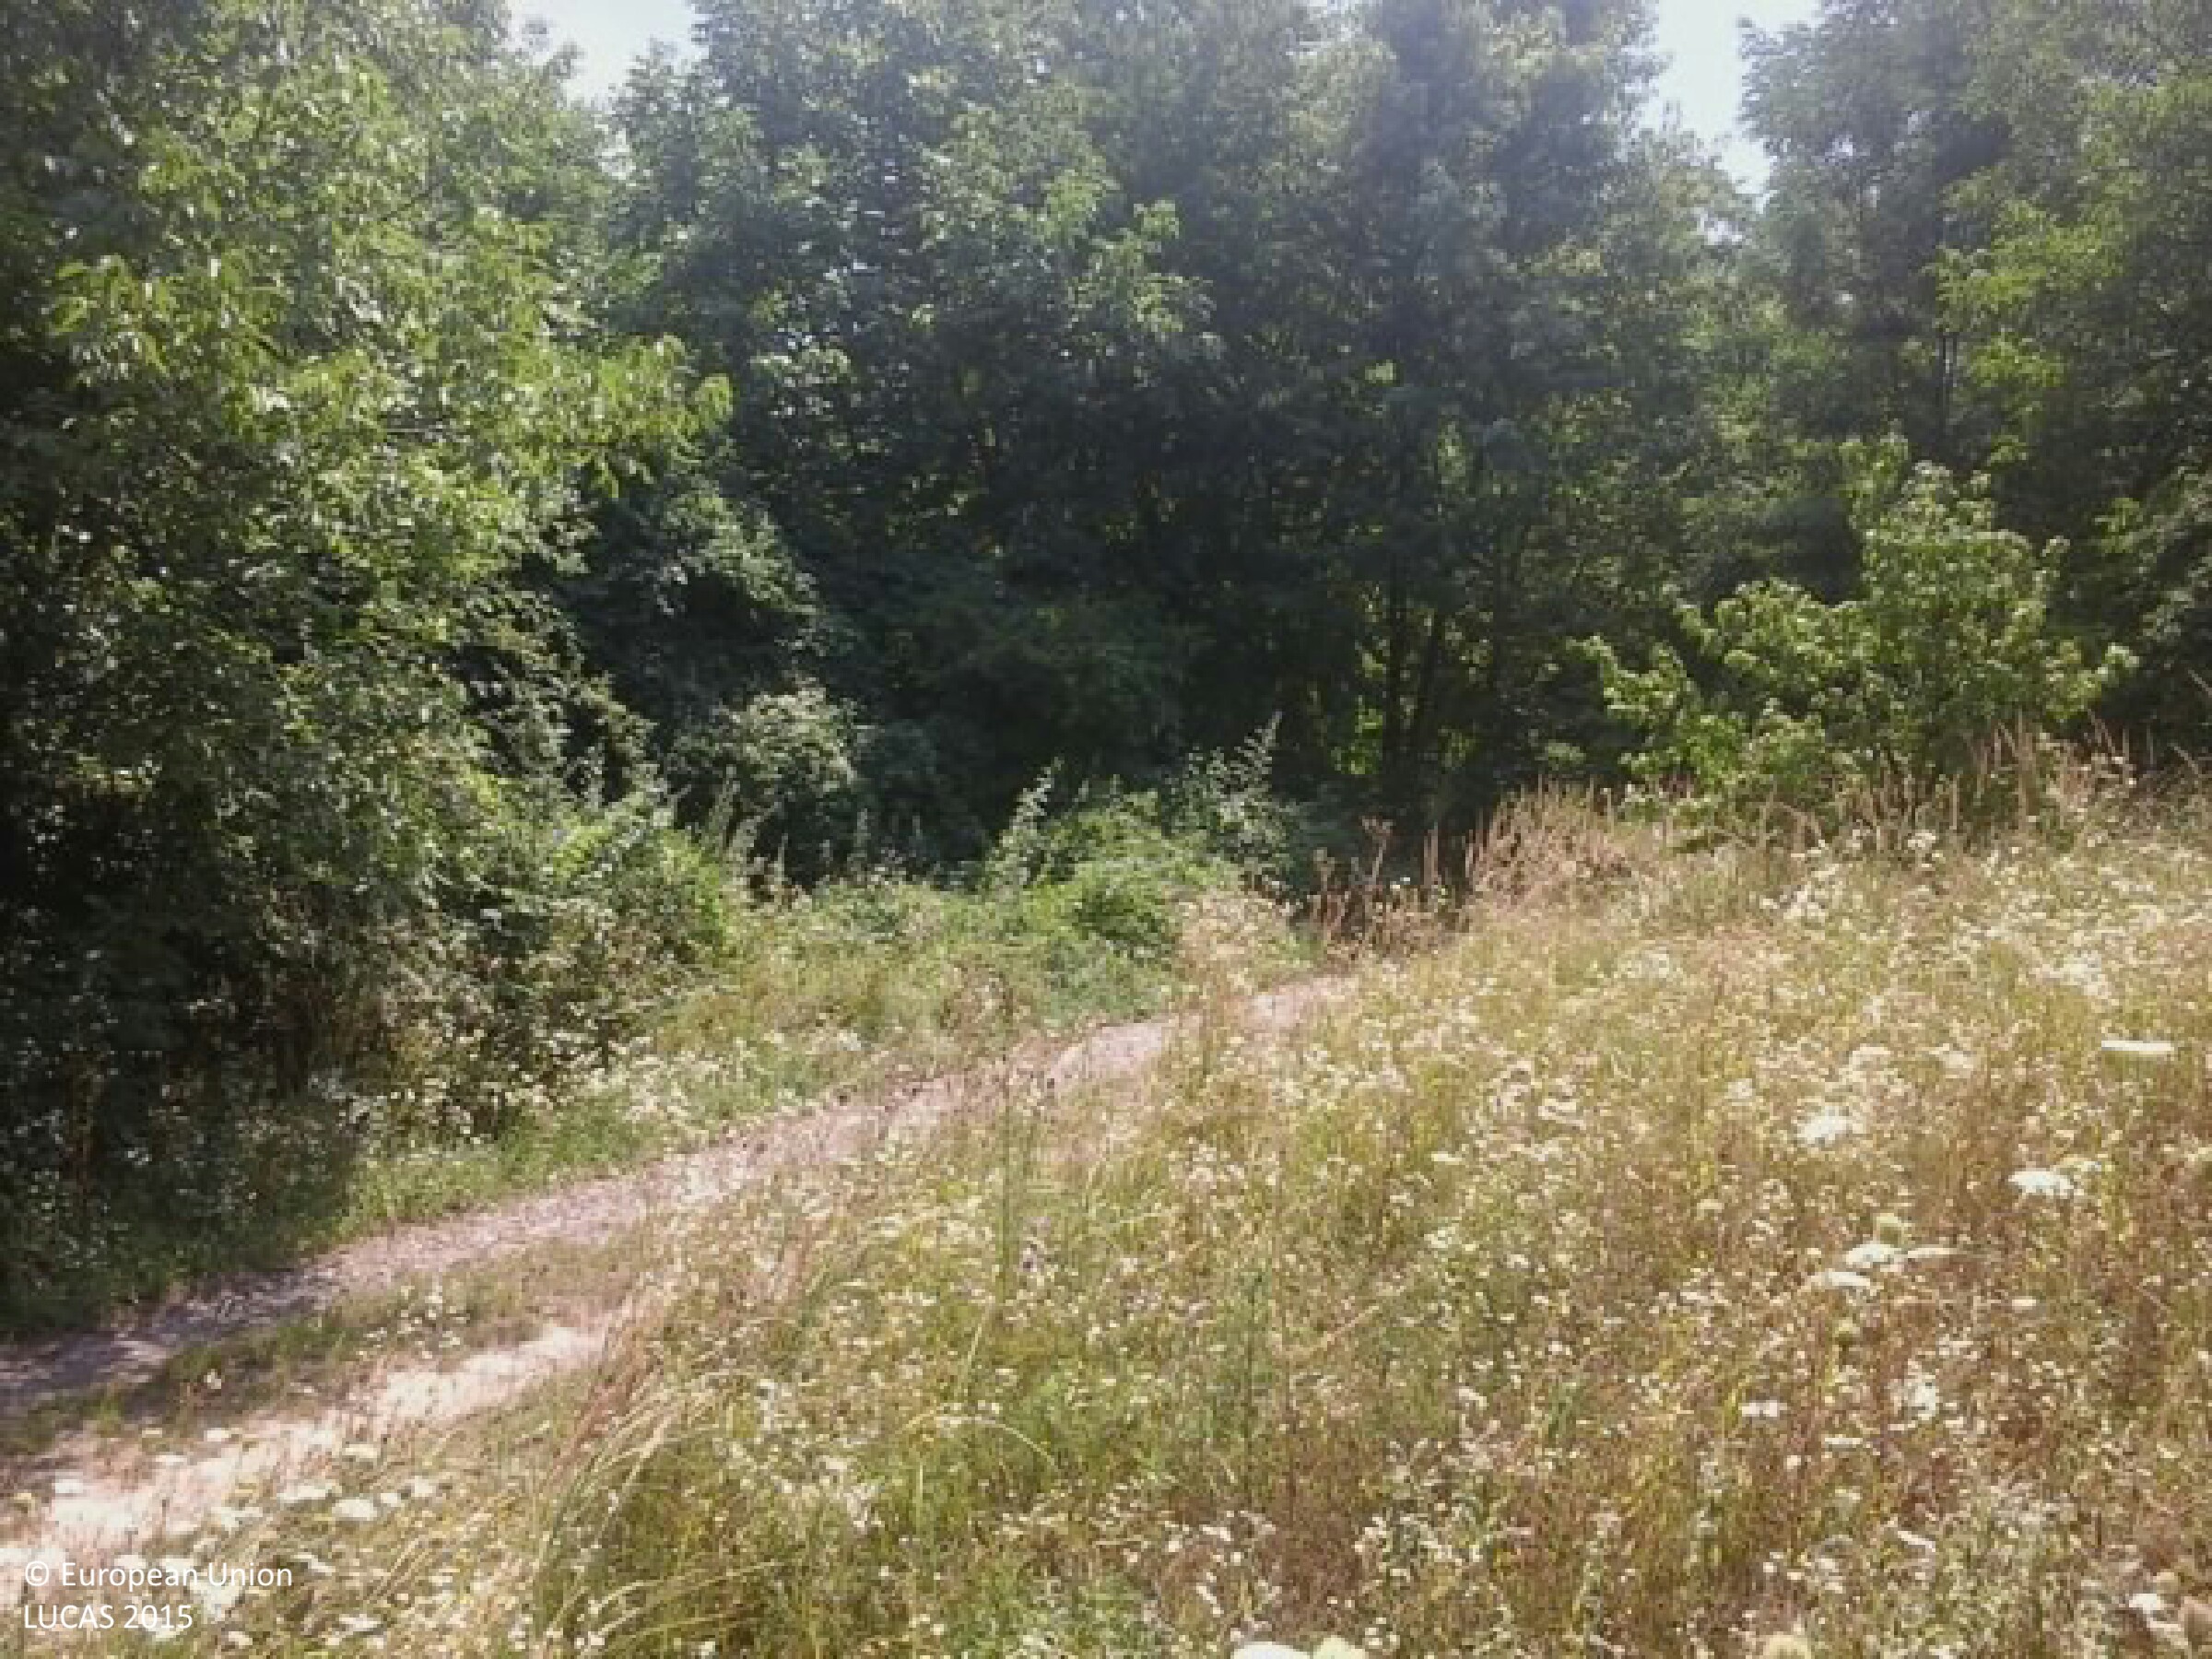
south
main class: Grassland
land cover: Grassland with sparse tree/shrub cover
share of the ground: > 75 %
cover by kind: herbaceous plants 85 %, shrubs 10 %, broadleaved forest trees 5 %
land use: Agriculture (excluding fallow land and kitchen gardens)
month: August
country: HU
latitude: 46.1961
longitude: 18.2361
